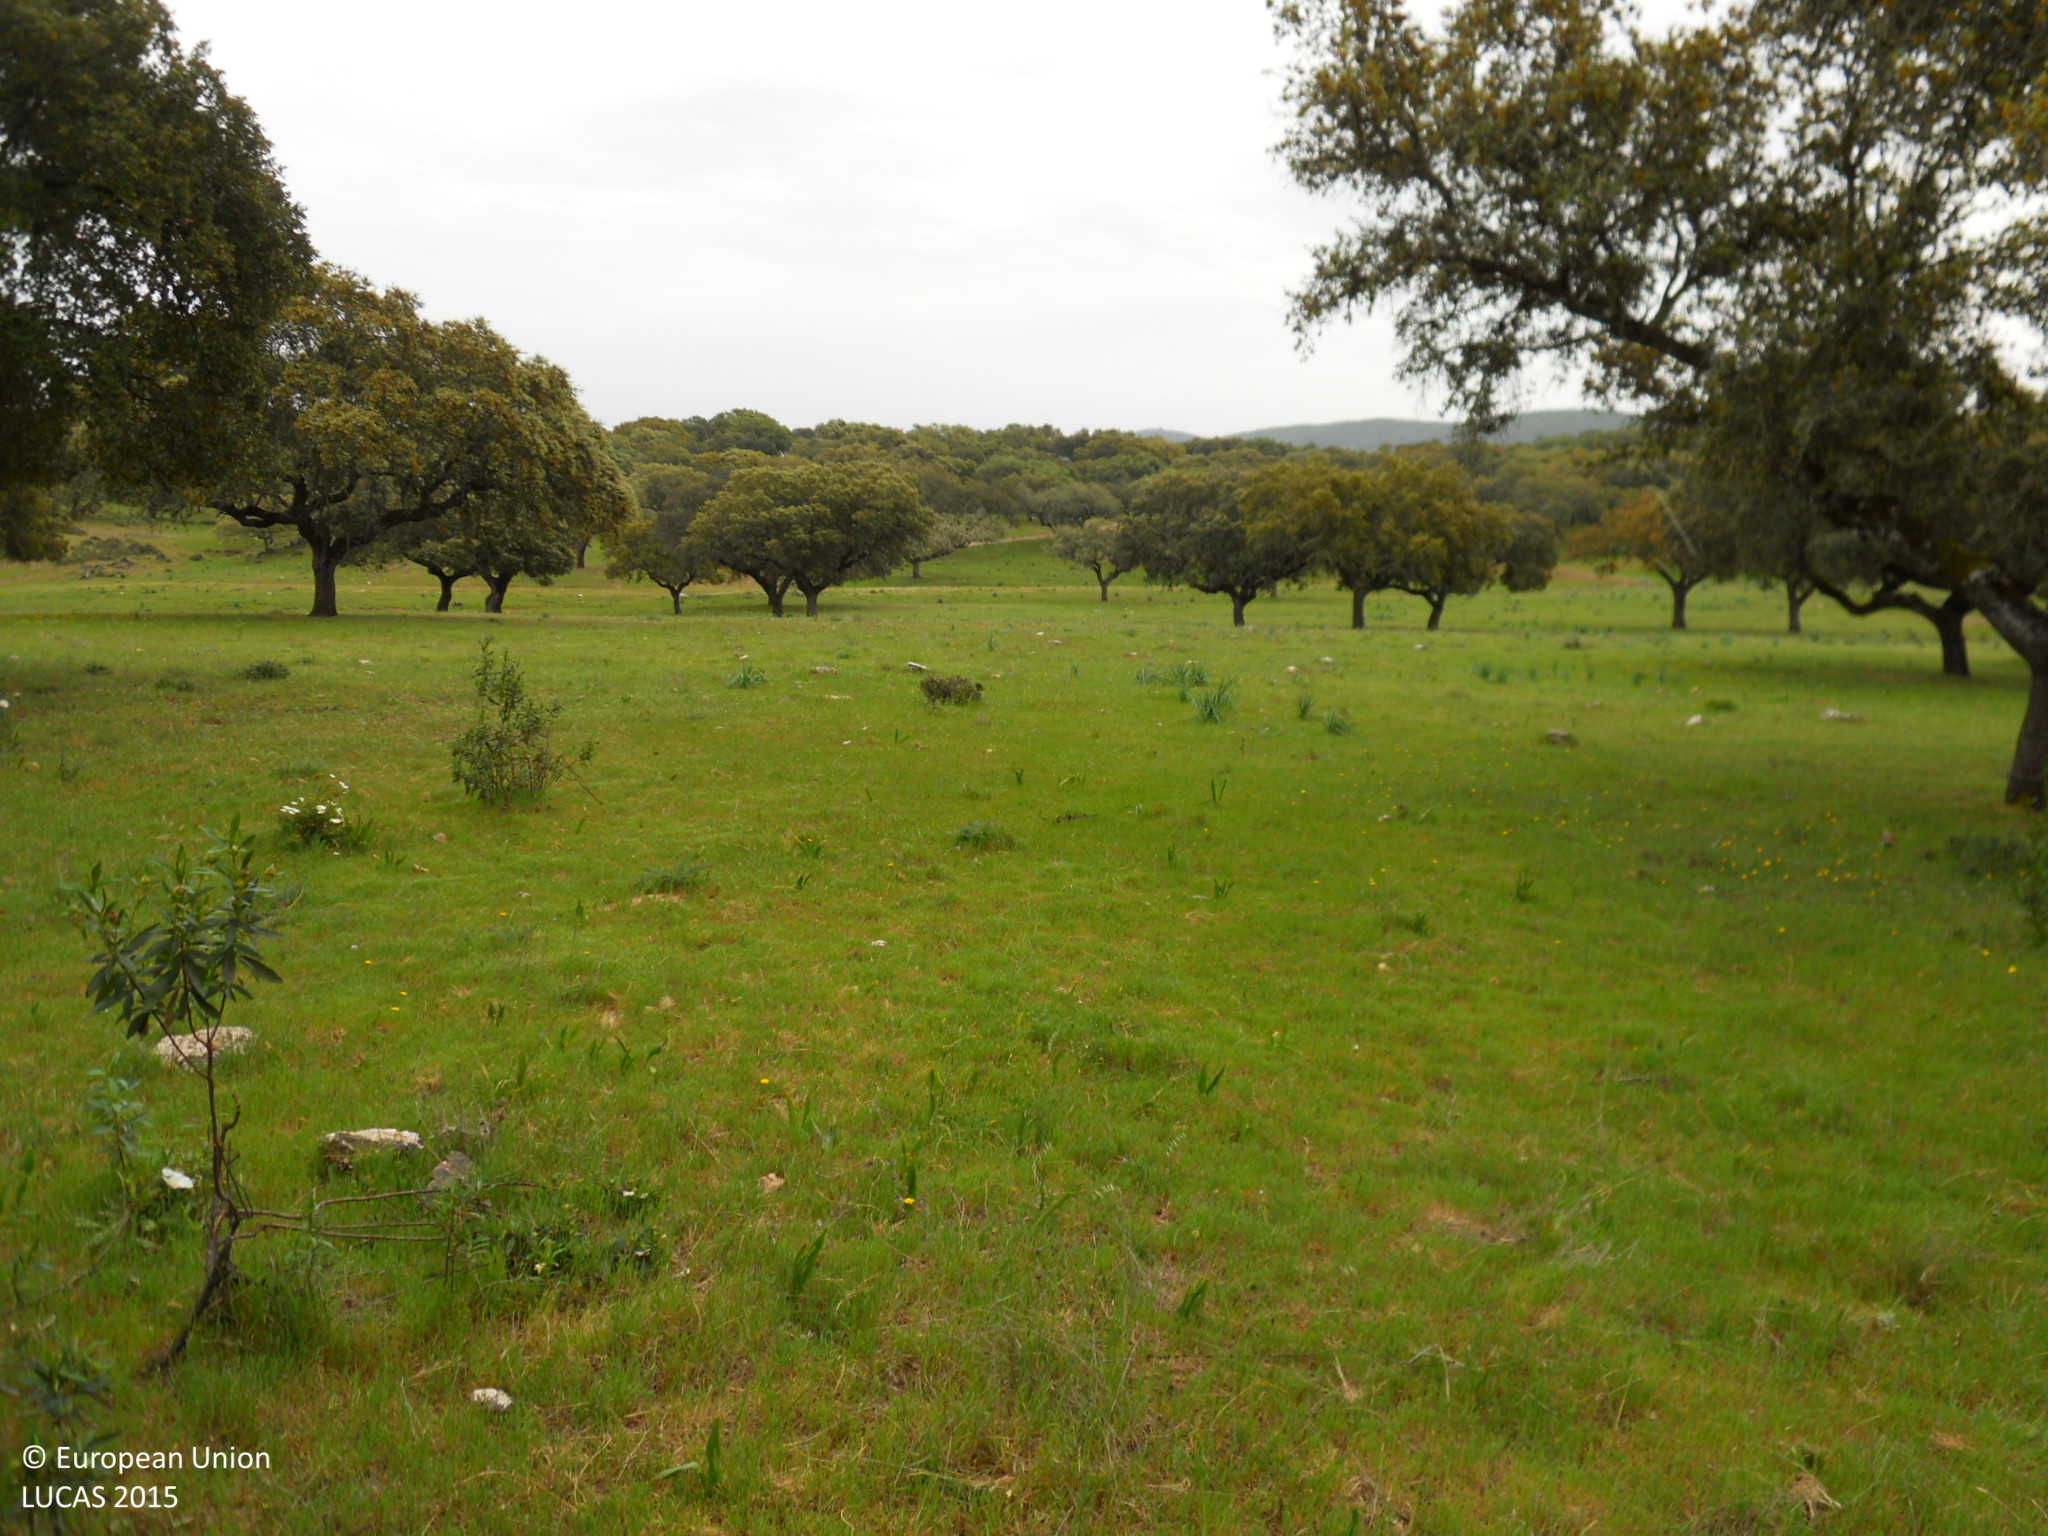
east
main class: Woodland
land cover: Broadleaved woodland
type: broadleaved evergreen forest
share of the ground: > 75 %
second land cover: Grassland without tree/shrub cover
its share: > 75 %
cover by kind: broadleaved forest trees 50 %, herbaceous plants 50 %
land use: Forestry
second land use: Agriculture (excluding fallow land and kitchen gardens)
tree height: > 5 m
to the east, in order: Broadleaved woodland; Grassland without tree/shrub cover; Rivers and streams; Broadleaved woodland; Tracks; Broadleaved woodland
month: April
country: ES
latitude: 39.1371
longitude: -6.5989
